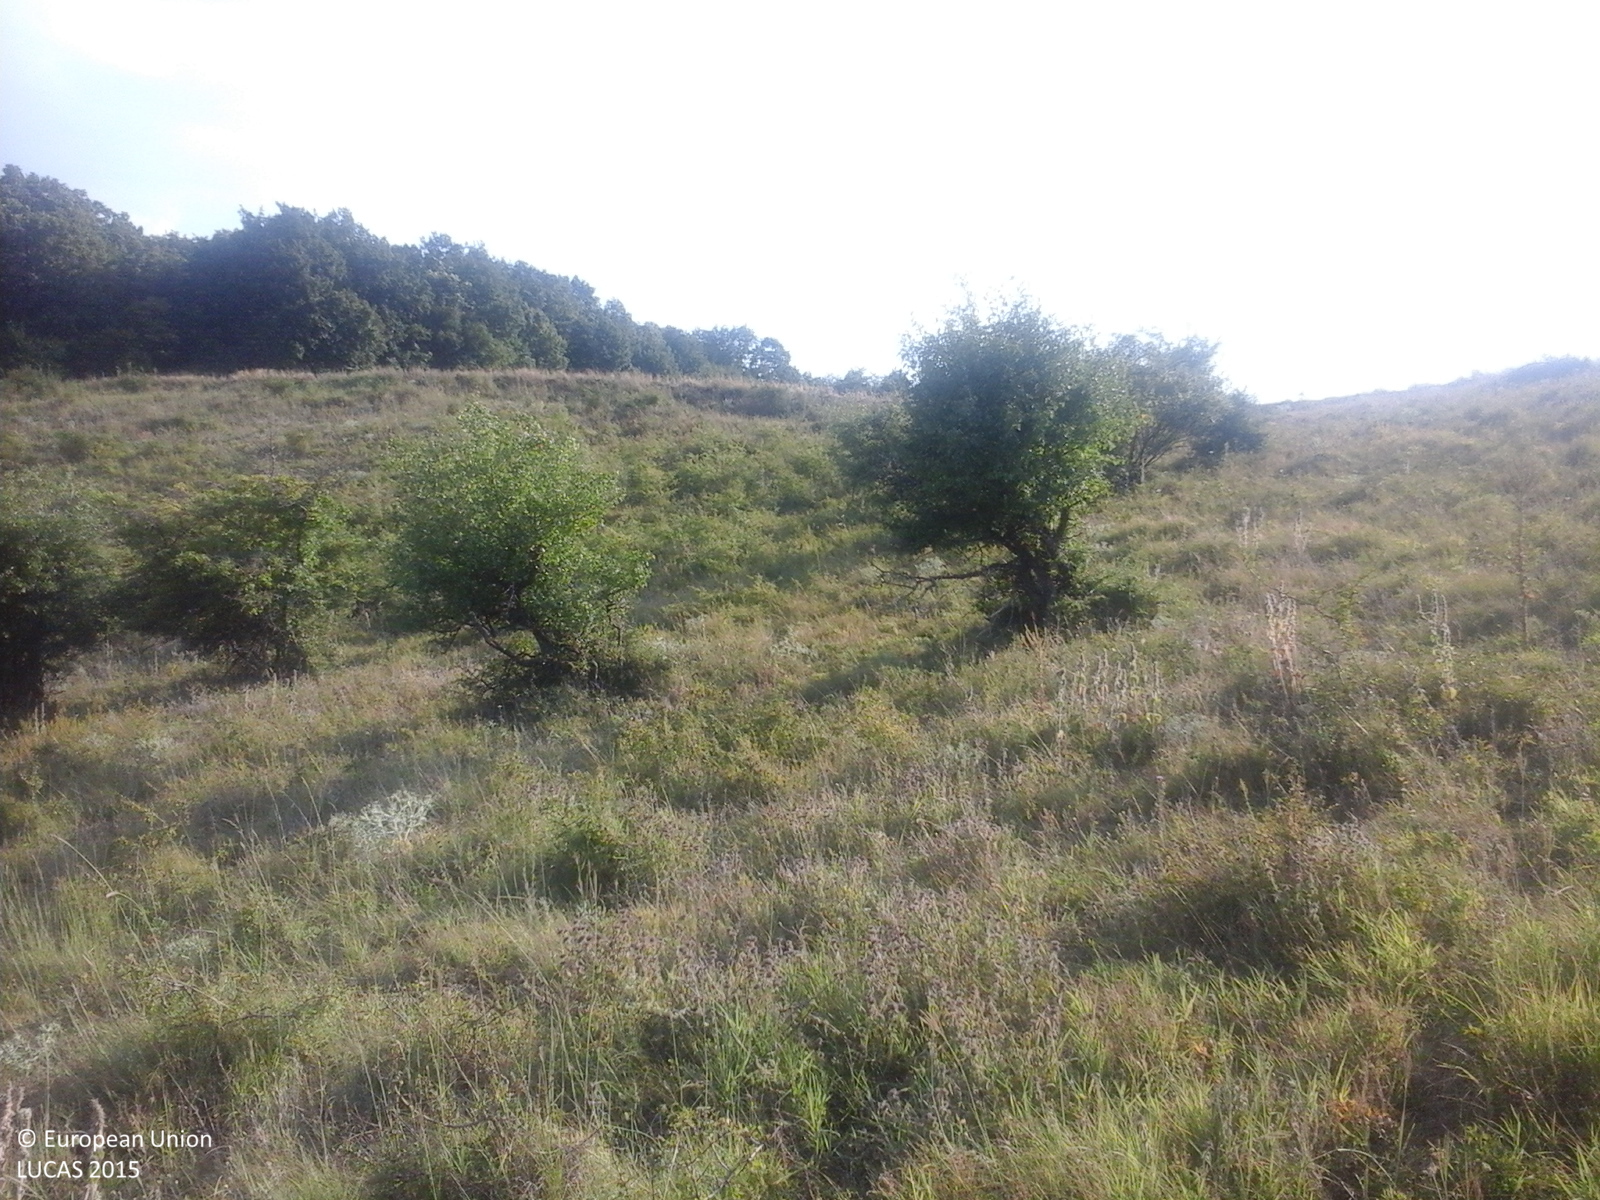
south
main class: Grassland
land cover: Grassland with sparse tree/shrub cover
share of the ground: > 75 %
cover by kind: herbaceous plants 85 %, shrubs 10 %, broadleaved forest trees 5 %
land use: Fallow land
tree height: > 5 m
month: July
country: RO
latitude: 46.5923
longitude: 28.0227
